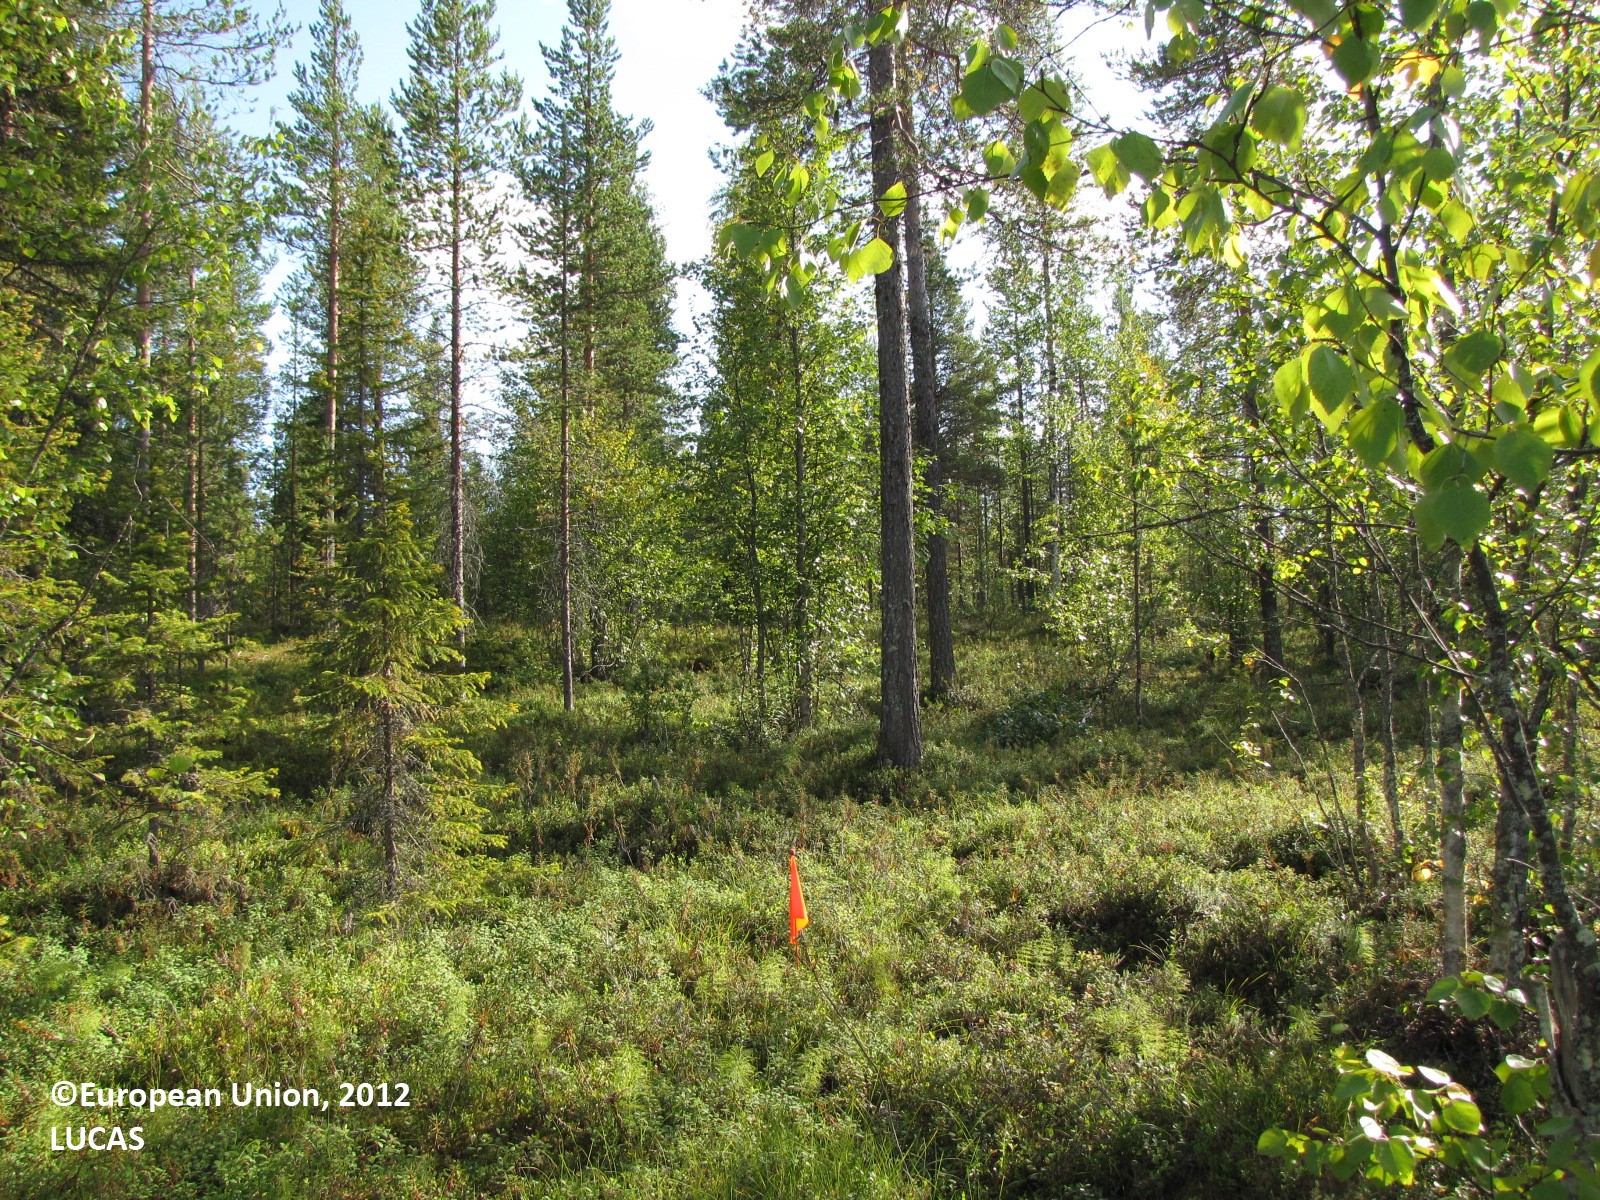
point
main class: Woodland
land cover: Pine dominated mixed woodland
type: boreal forest
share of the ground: 25 - 50 %
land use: Forestry
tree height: > 5 m
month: August
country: FI
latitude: 66.9681
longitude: 25.2375
